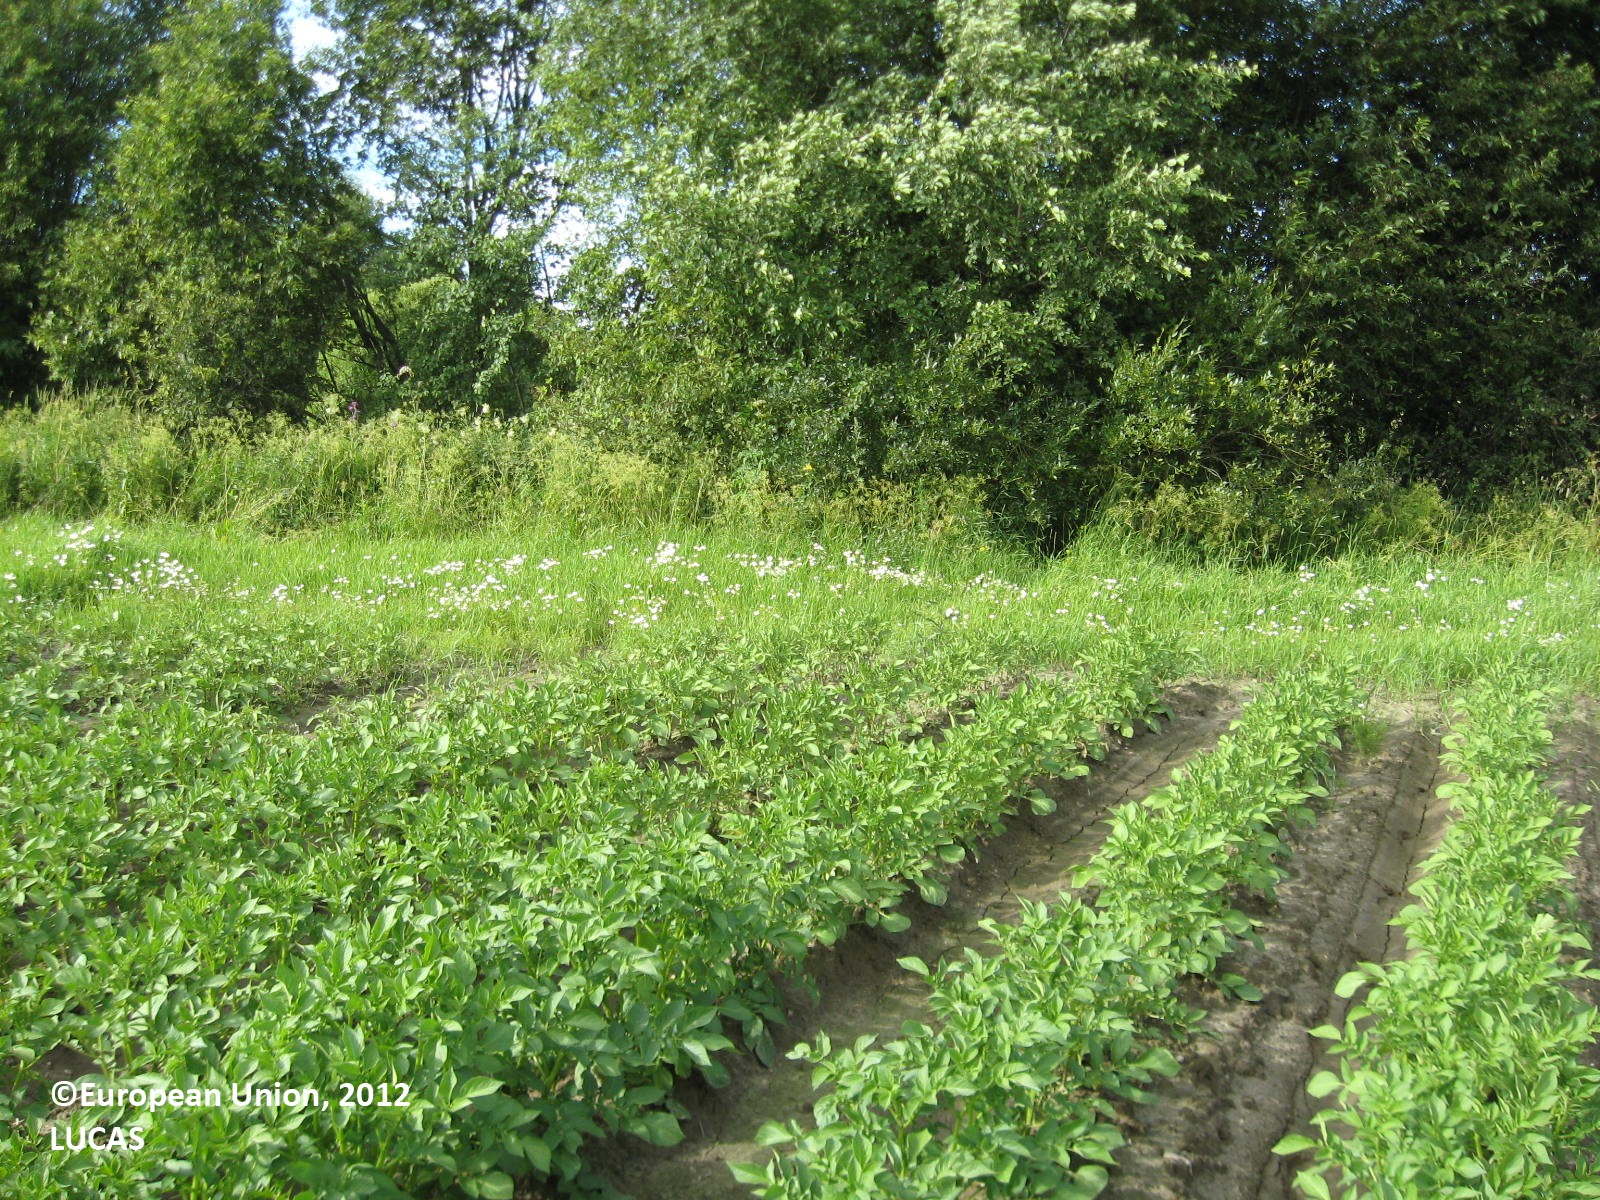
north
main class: Cropland
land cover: Potatoes
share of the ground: 50 - 75 %
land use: Agriculture (excluding fallow land and kitchen gardens)
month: July
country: FI
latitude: 62.2583
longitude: 21.5420
